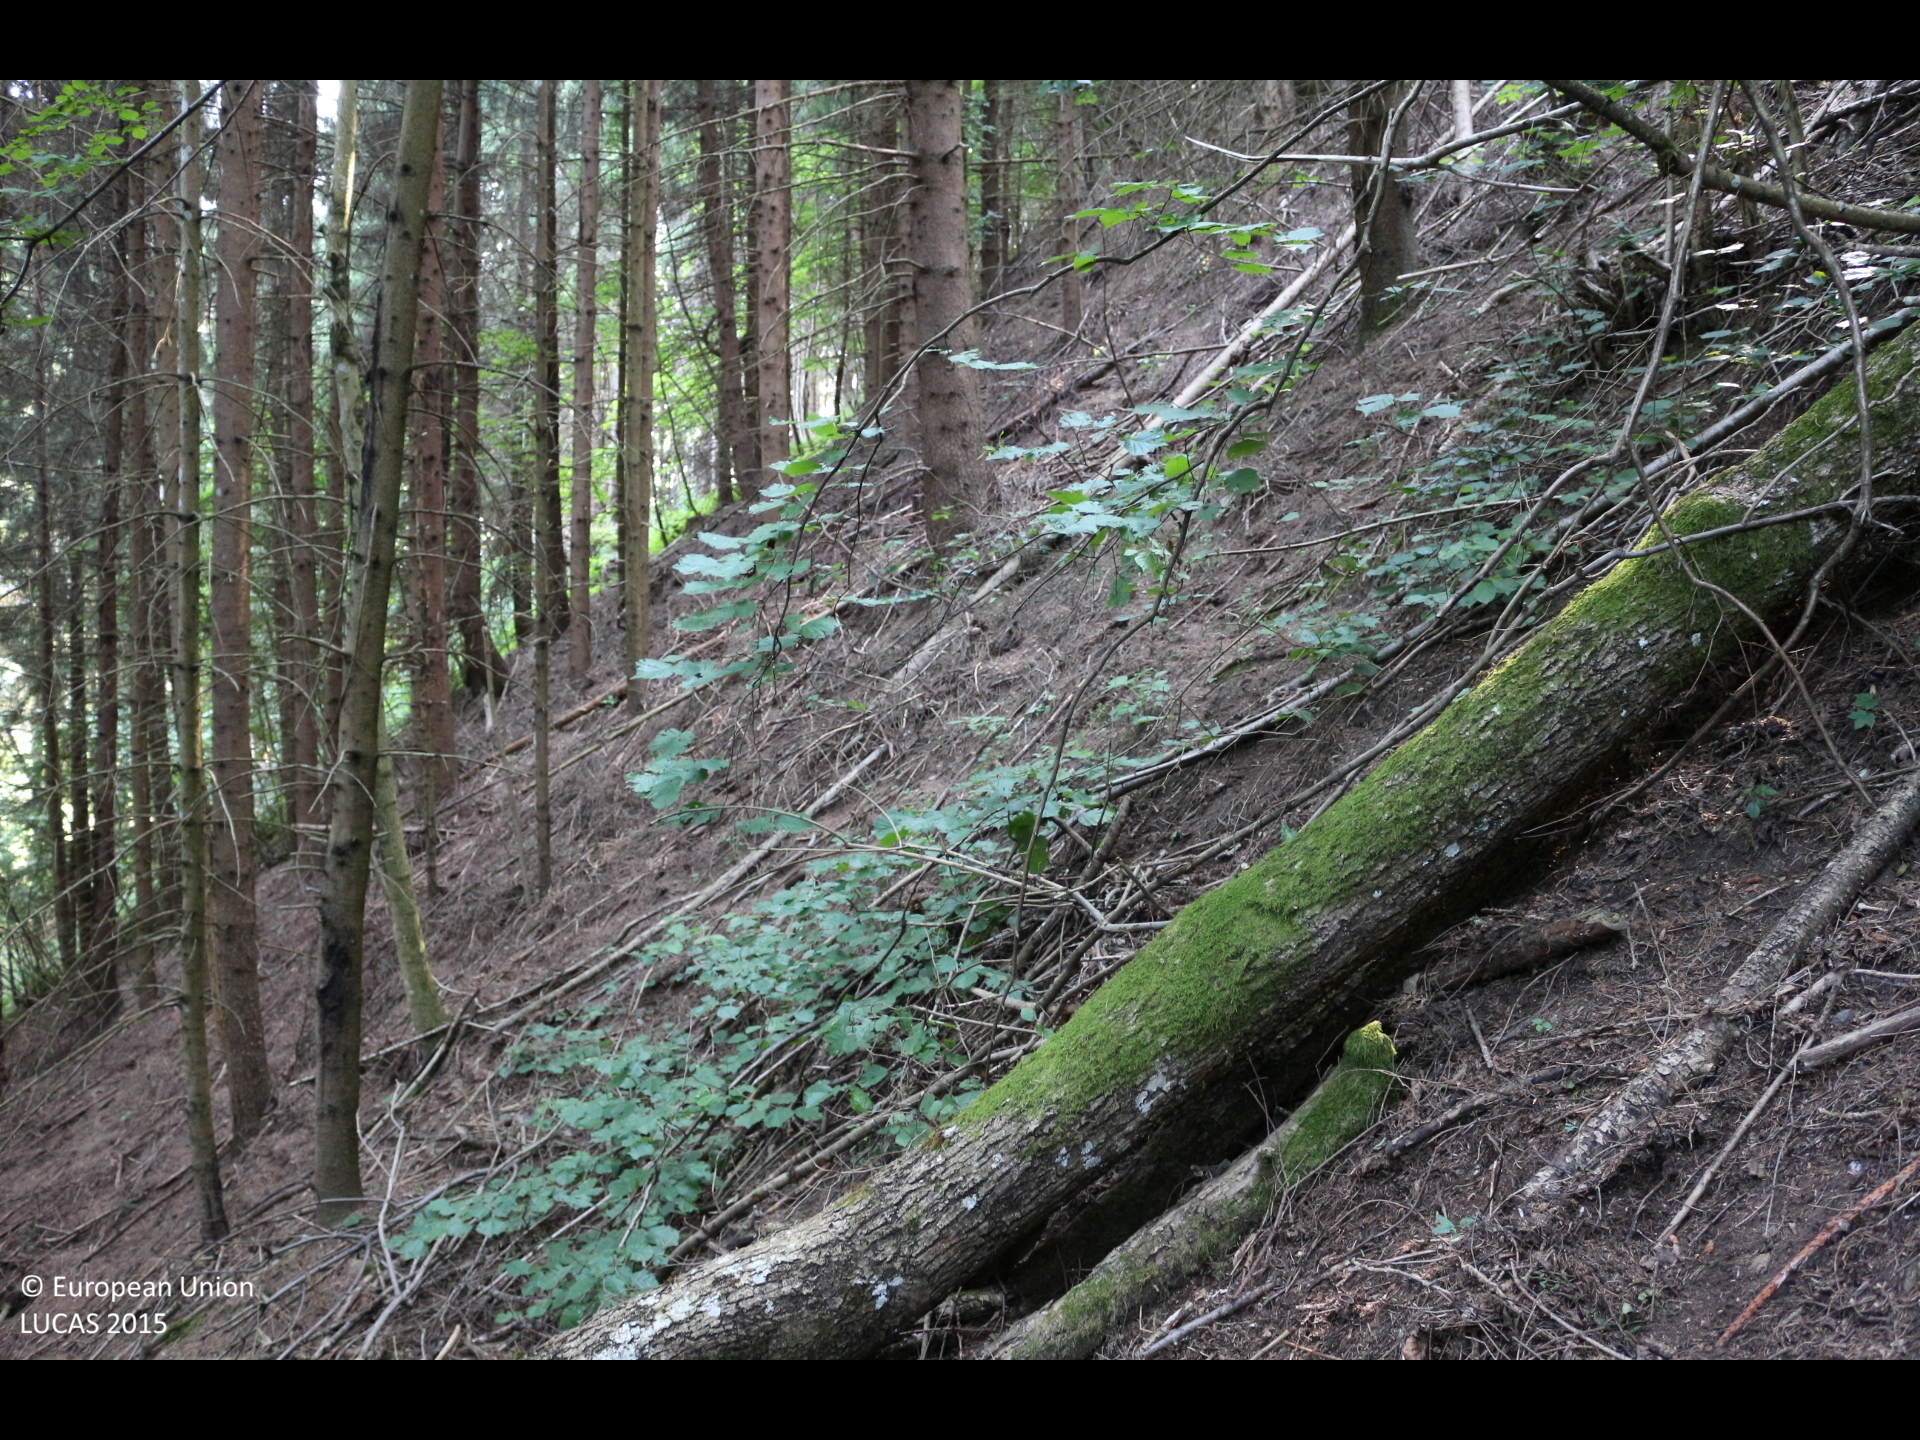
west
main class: Woodland
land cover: Spruce dominated mixed woodland
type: alpine coniferous forest
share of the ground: > 75 %
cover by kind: coniferous forest trees 60 %, broadleaved forest trees 40 %
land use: Forestry
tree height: > 5 m
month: July
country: AT
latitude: 46.7767
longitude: 14.1231
